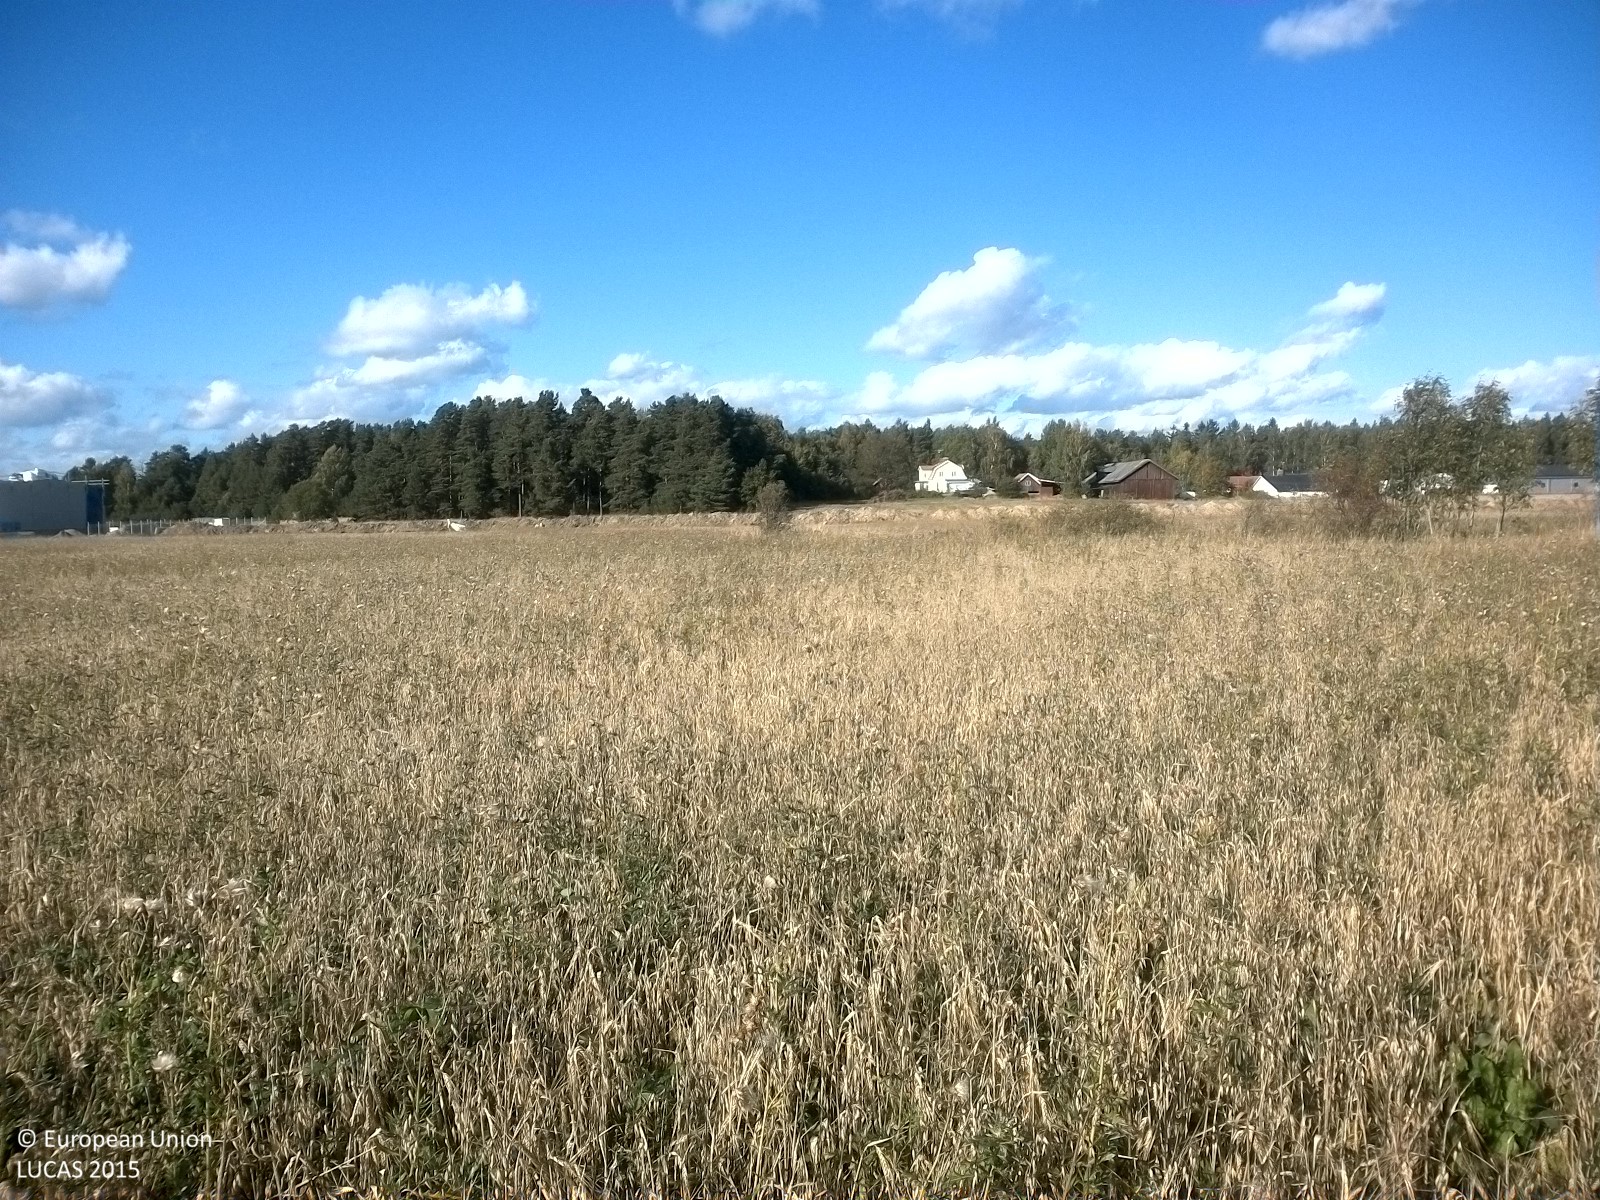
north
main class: Grassland
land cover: Spontaneously vegetated surfaces
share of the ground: > 75 %
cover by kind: herbaceous plants 100 %
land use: Agriculture (excluding fallow land and kitchen gardens)
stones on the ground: < 10 %
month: September
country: SE
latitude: 58.4235
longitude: 15.6963
